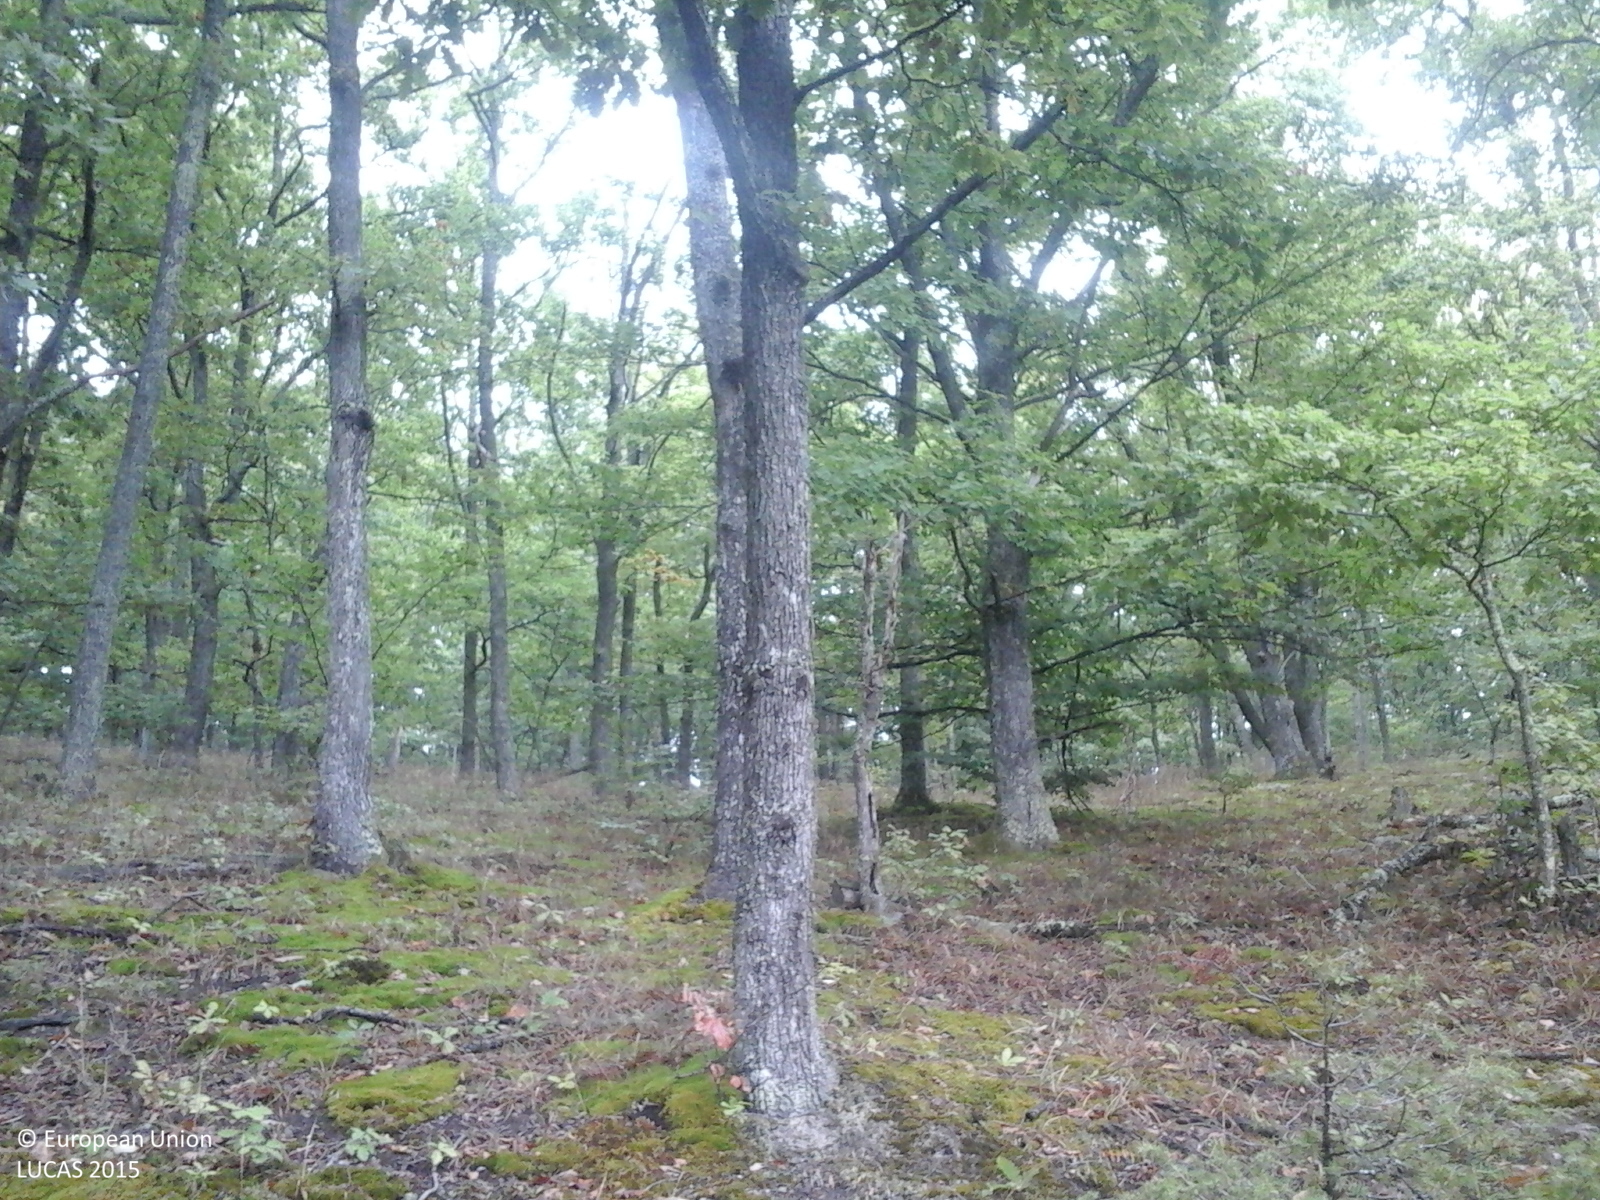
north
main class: Woodland
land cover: Broadleaved woodland
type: acidophilous oak and oak-birch forest
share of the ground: > 75 %
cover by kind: broadleaved forest trees 100 %
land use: Forestry
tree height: > 5 m
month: September
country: RO
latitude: 45.7393
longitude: 22.2139
